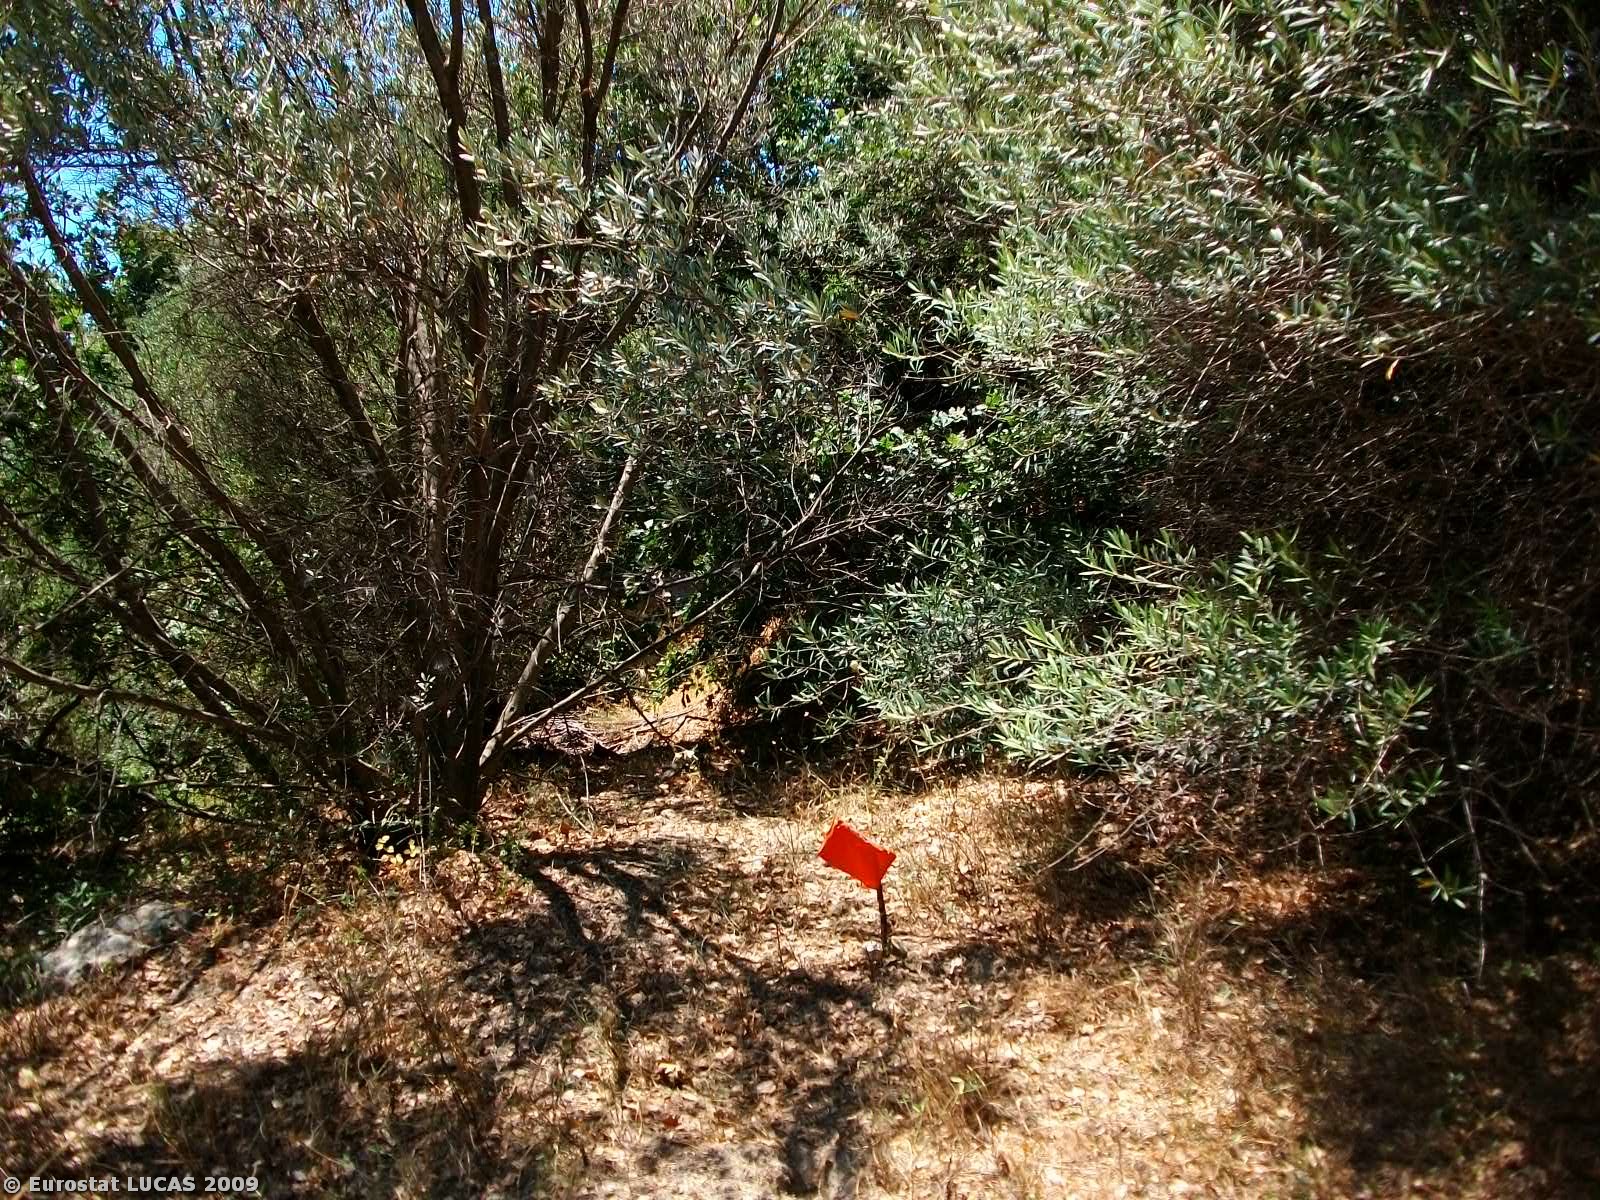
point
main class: Cropland
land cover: Olive groves
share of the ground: 50 - 75 %
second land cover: Bare land
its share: 50 - 75 %
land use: Agriculture (excluding fallow land and kitchen gardens)
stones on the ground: 10 - 25 %
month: May
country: GR
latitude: 35.2438
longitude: 24.9905
